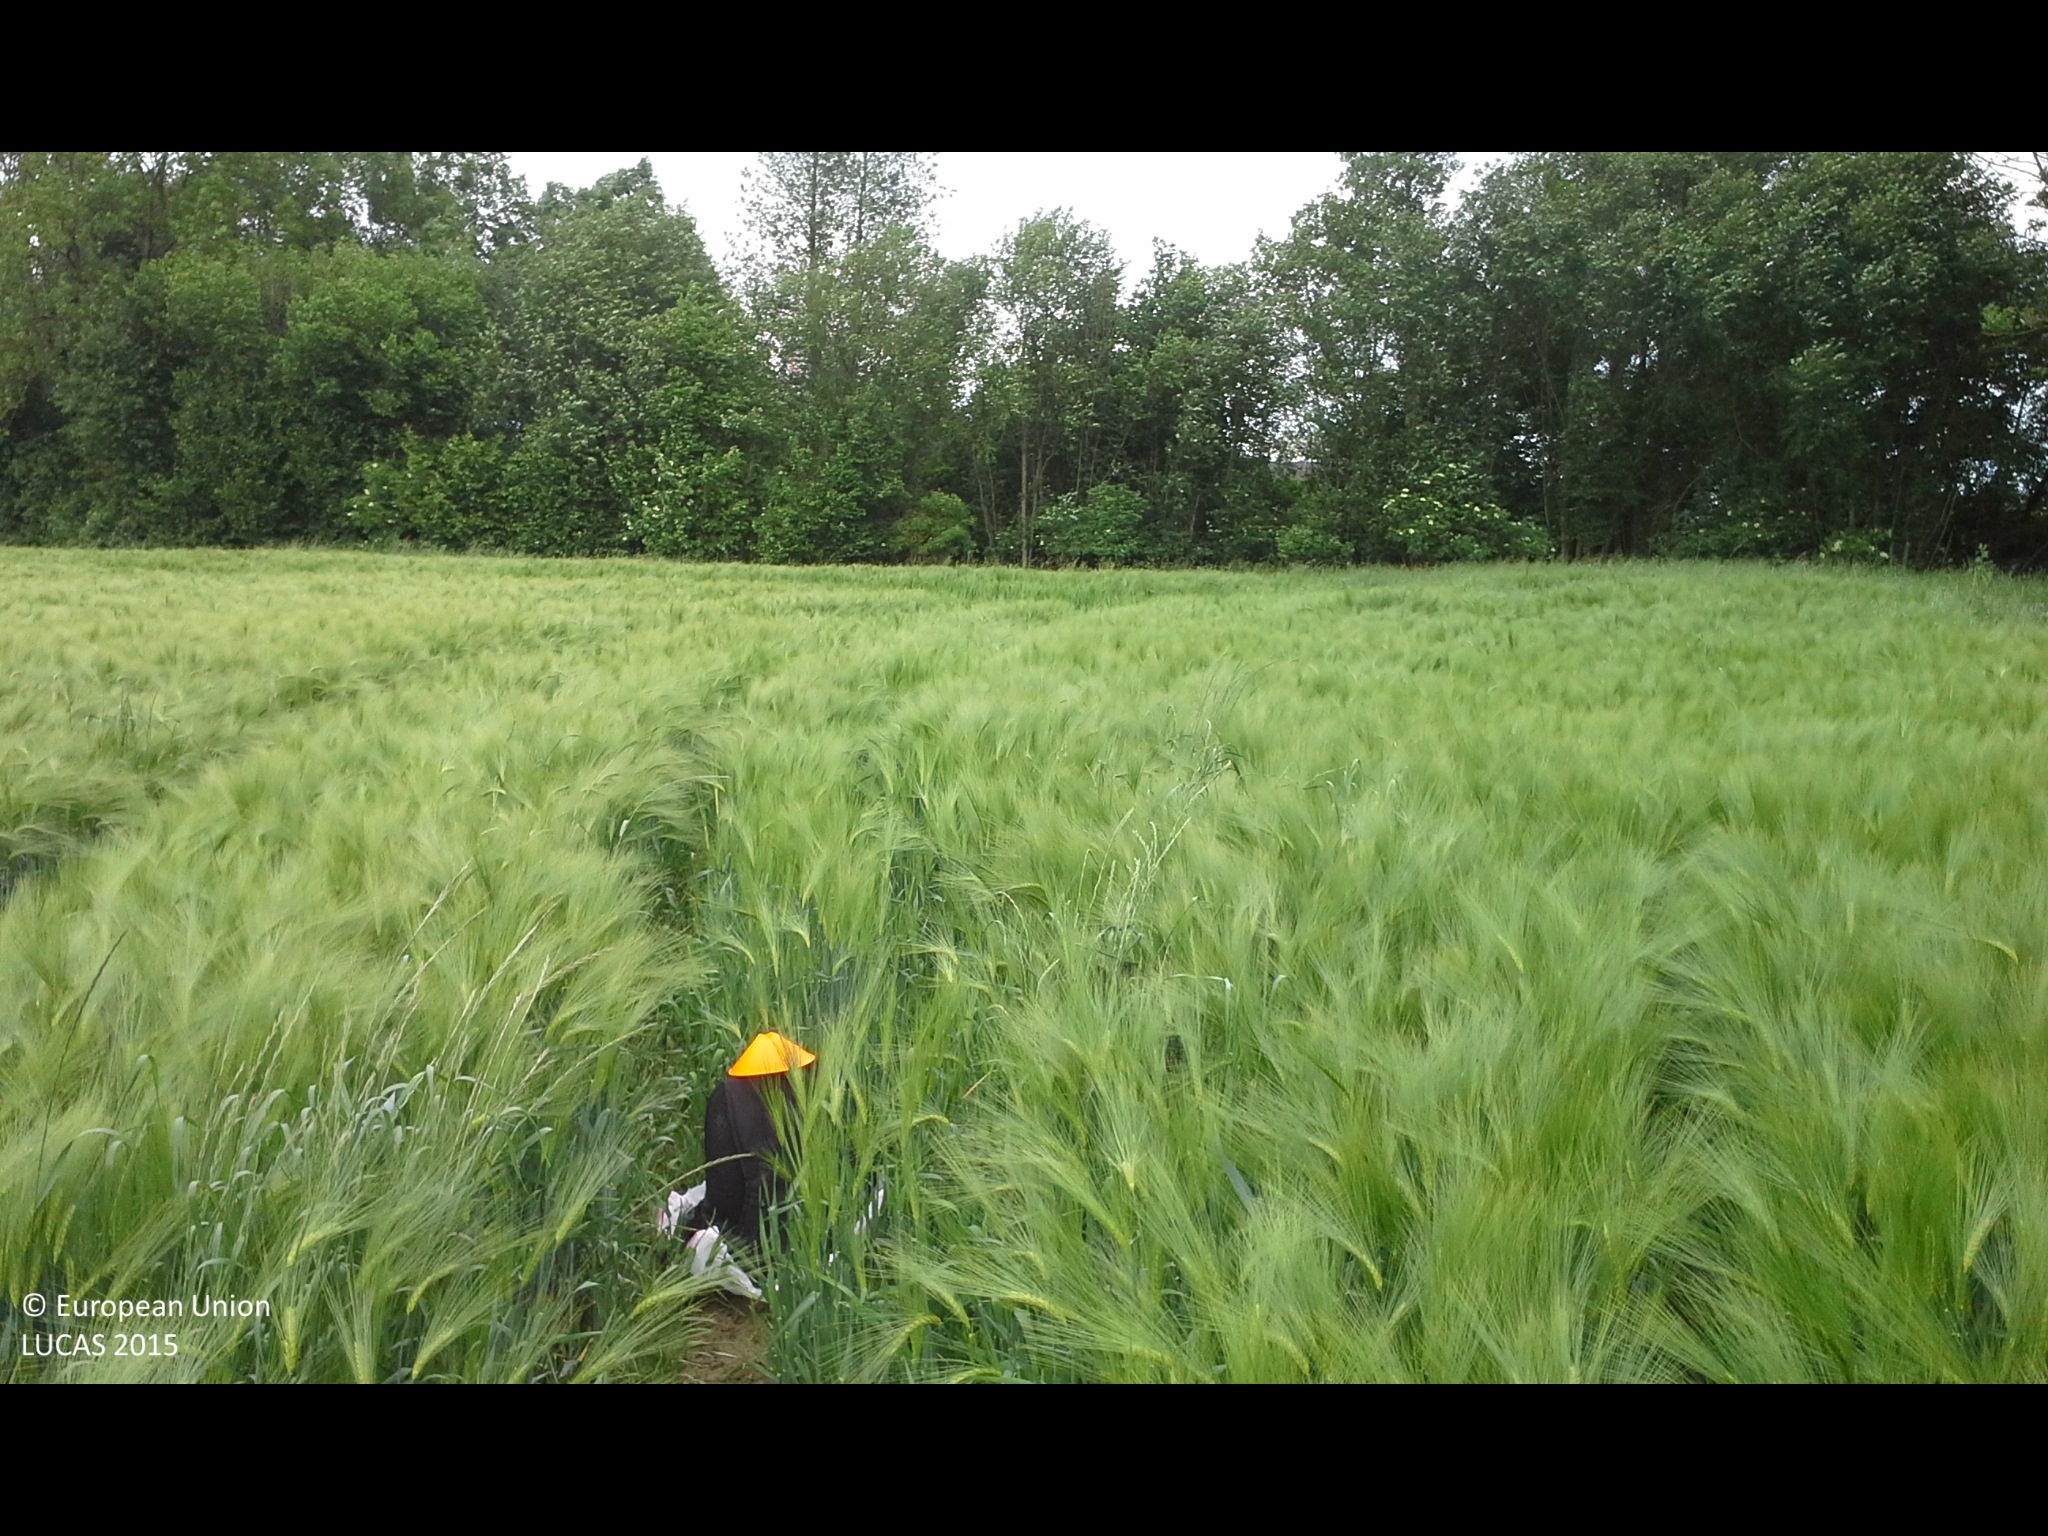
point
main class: Cropland
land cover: Barley
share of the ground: > 75 %
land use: Agriculture (excluding fallow land and kitchen gardens)
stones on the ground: < 10 %
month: May
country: AT
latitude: 48.2067
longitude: 14.4273
